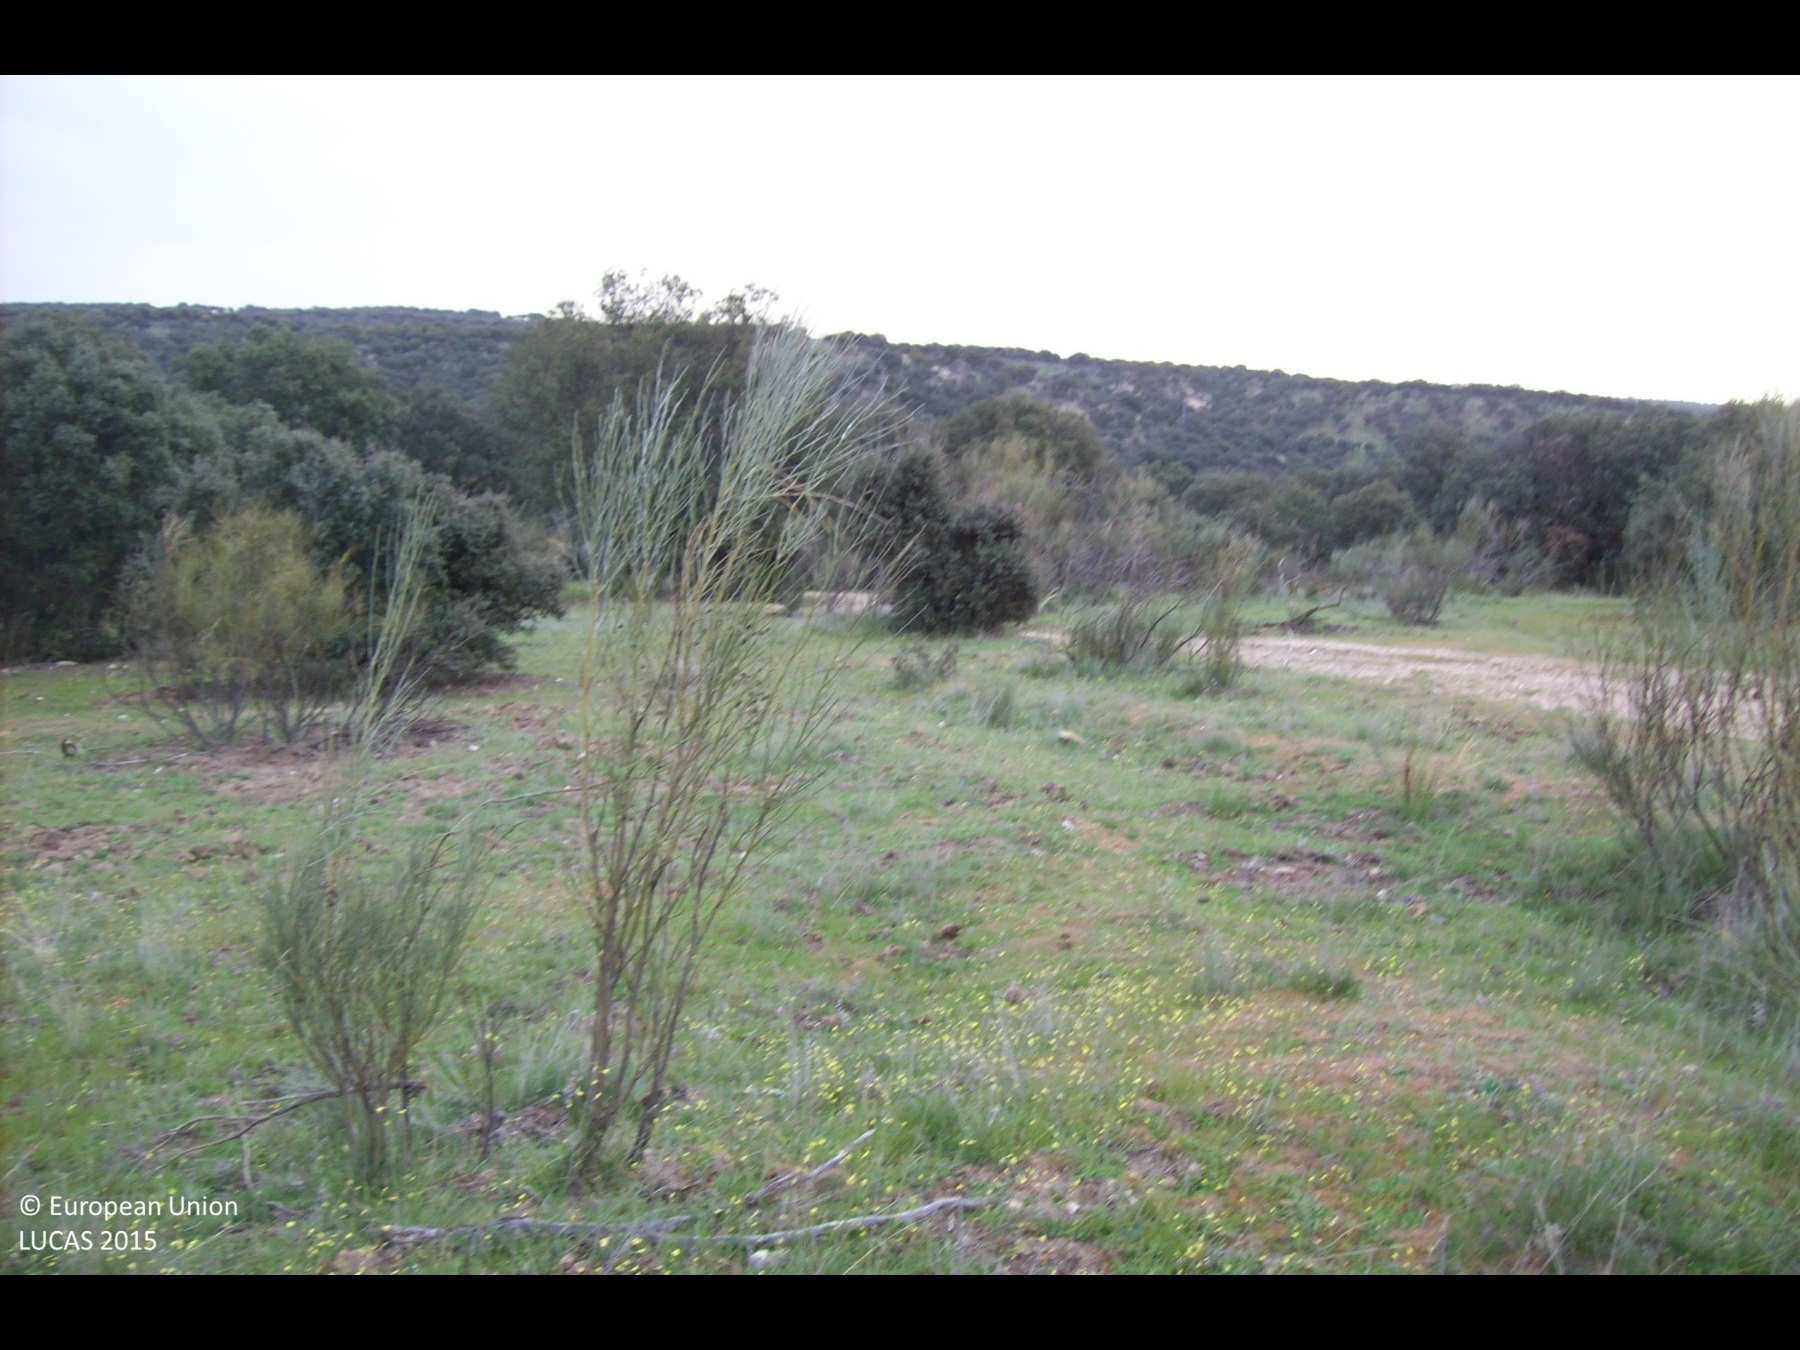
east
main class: Grassland
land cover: Grassland with sparse tree/shrub cover
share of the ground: > 75 %
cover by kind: herbaceous plants 85 %, broadleaved forest trees 5 %, shrubs 5 %
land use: Semi-natural and natural areas not in use
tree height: < 5 m
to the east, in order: Grassland with sparse tree/shrub cover; Broadleaved woodland; Tracks; Broadleaved woodland; Tracks; Broadleaved woodland; Tracks; Dry stone walls; Fences; Broadleaved woodland; Tracks; Broadleaved woodland
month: April
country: ES
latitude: 40.5415
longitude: -3.8675
